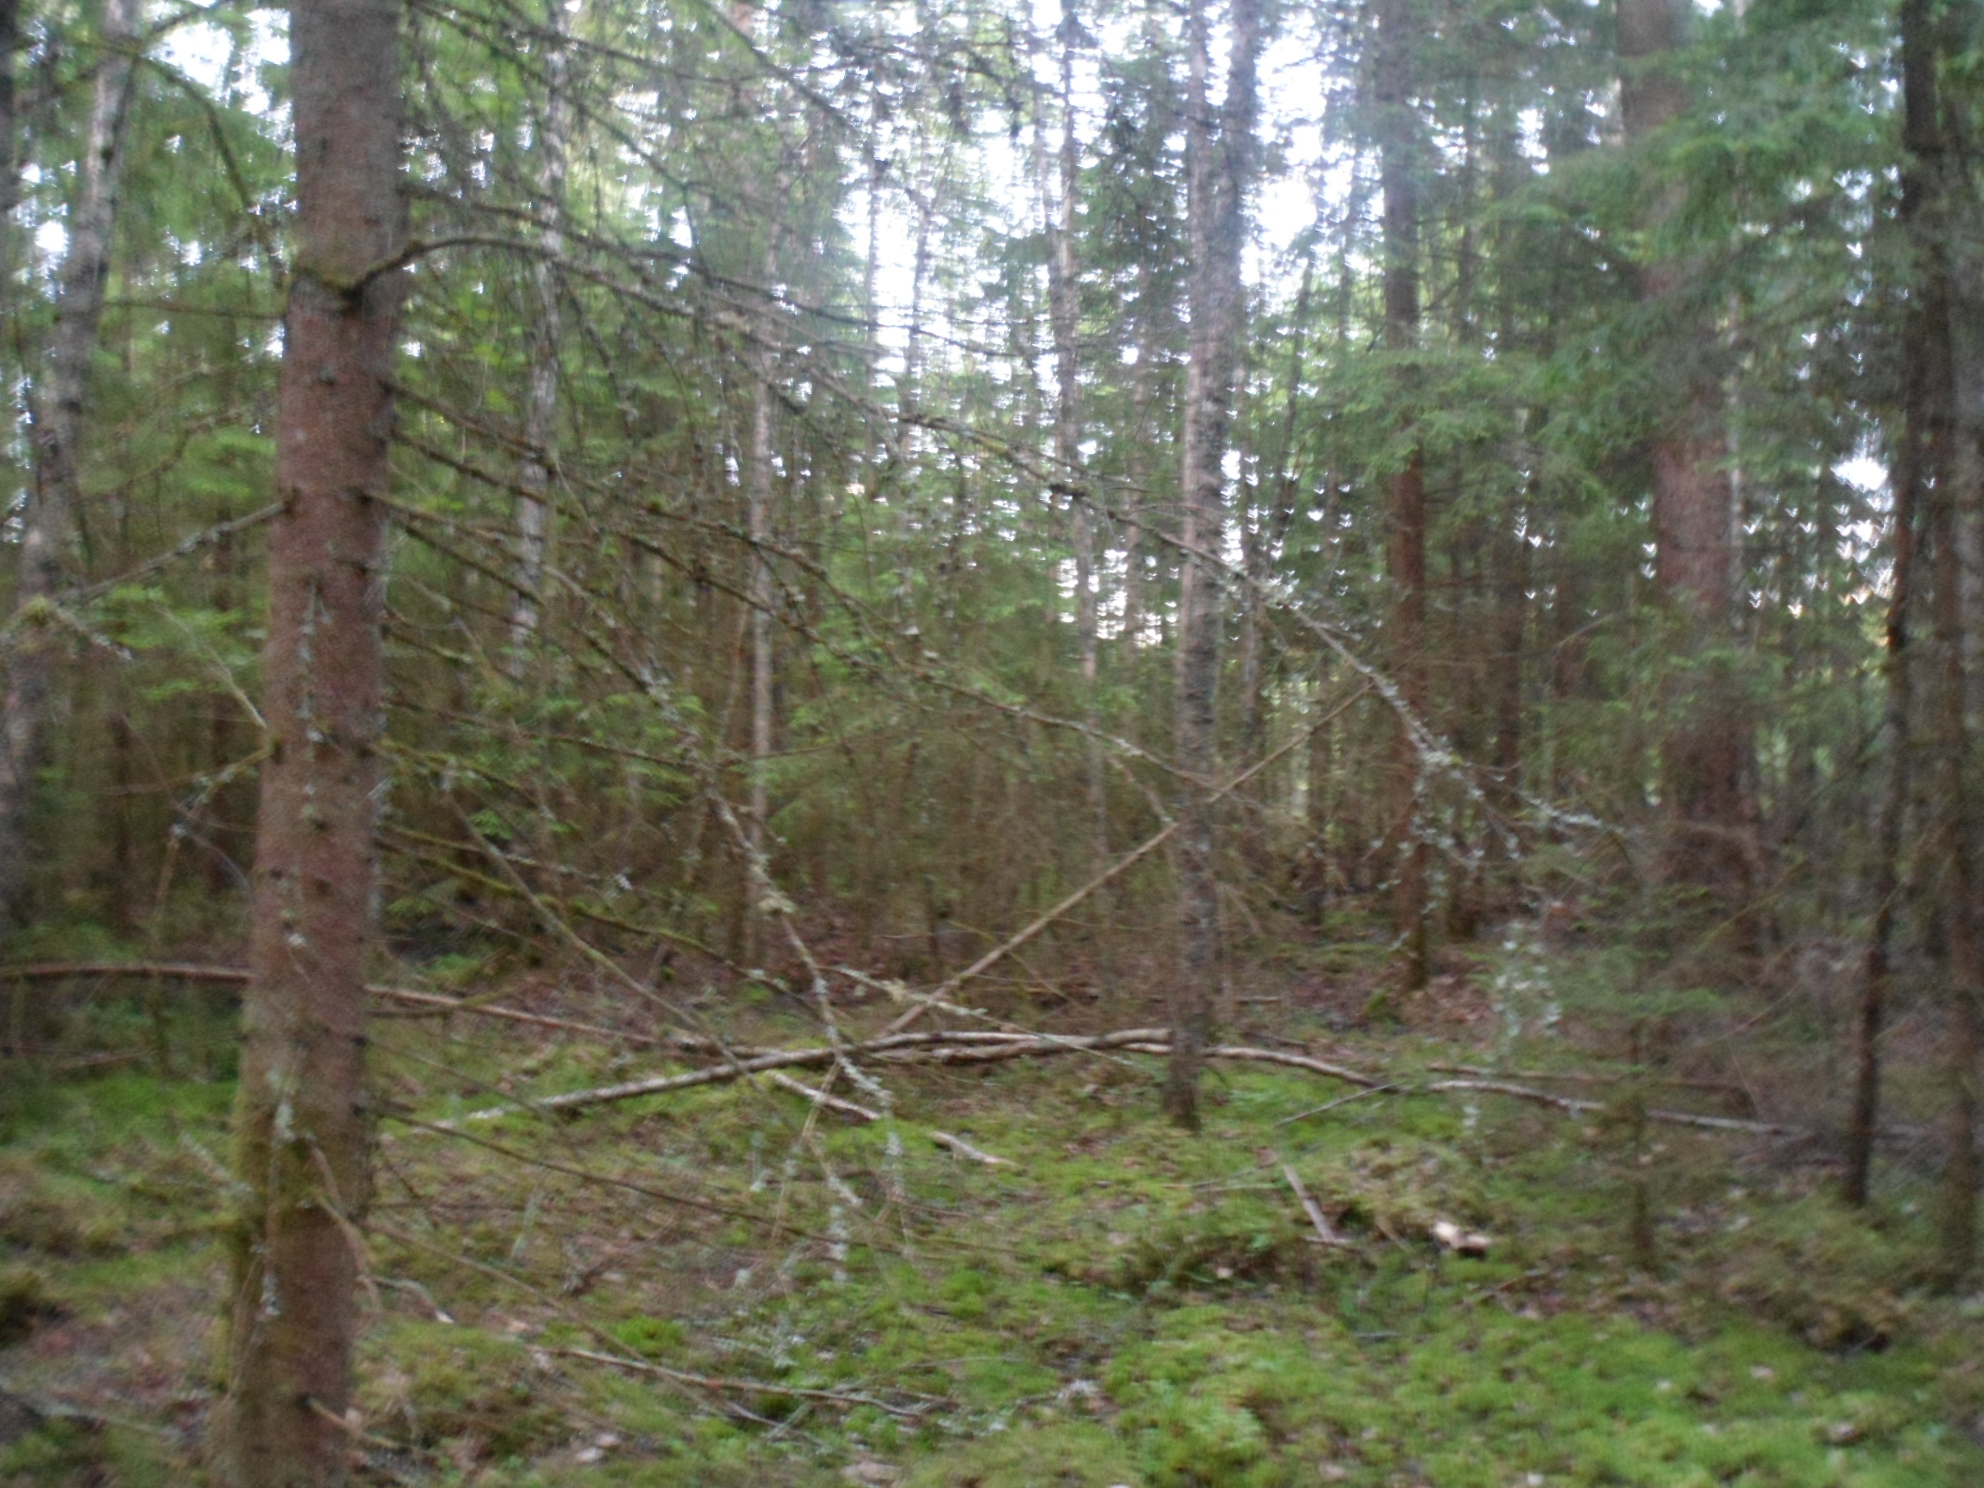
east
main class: Woodland
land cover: Spruce dominated mixed woodland
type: boreal forest
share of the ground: > 75 %
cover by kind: coniferous forest trees 50 %, broadleaved forest trees 30 %, lichens and mosses 15 %, herbaceous plants 5 %
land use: Forestry
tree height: > 5 m
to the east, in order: Spruce dominated mixed woodland; Spruce dominated coniferous woodland; Broadleaved woodland; Spruce dominated mixed woodland; Broadleaved woodland; Shrubland with sparse tree cover; Broadleaved woodland; Spruce dominated mixed woodland
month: June
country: SE
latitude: 57.2776
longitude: 14.5574
